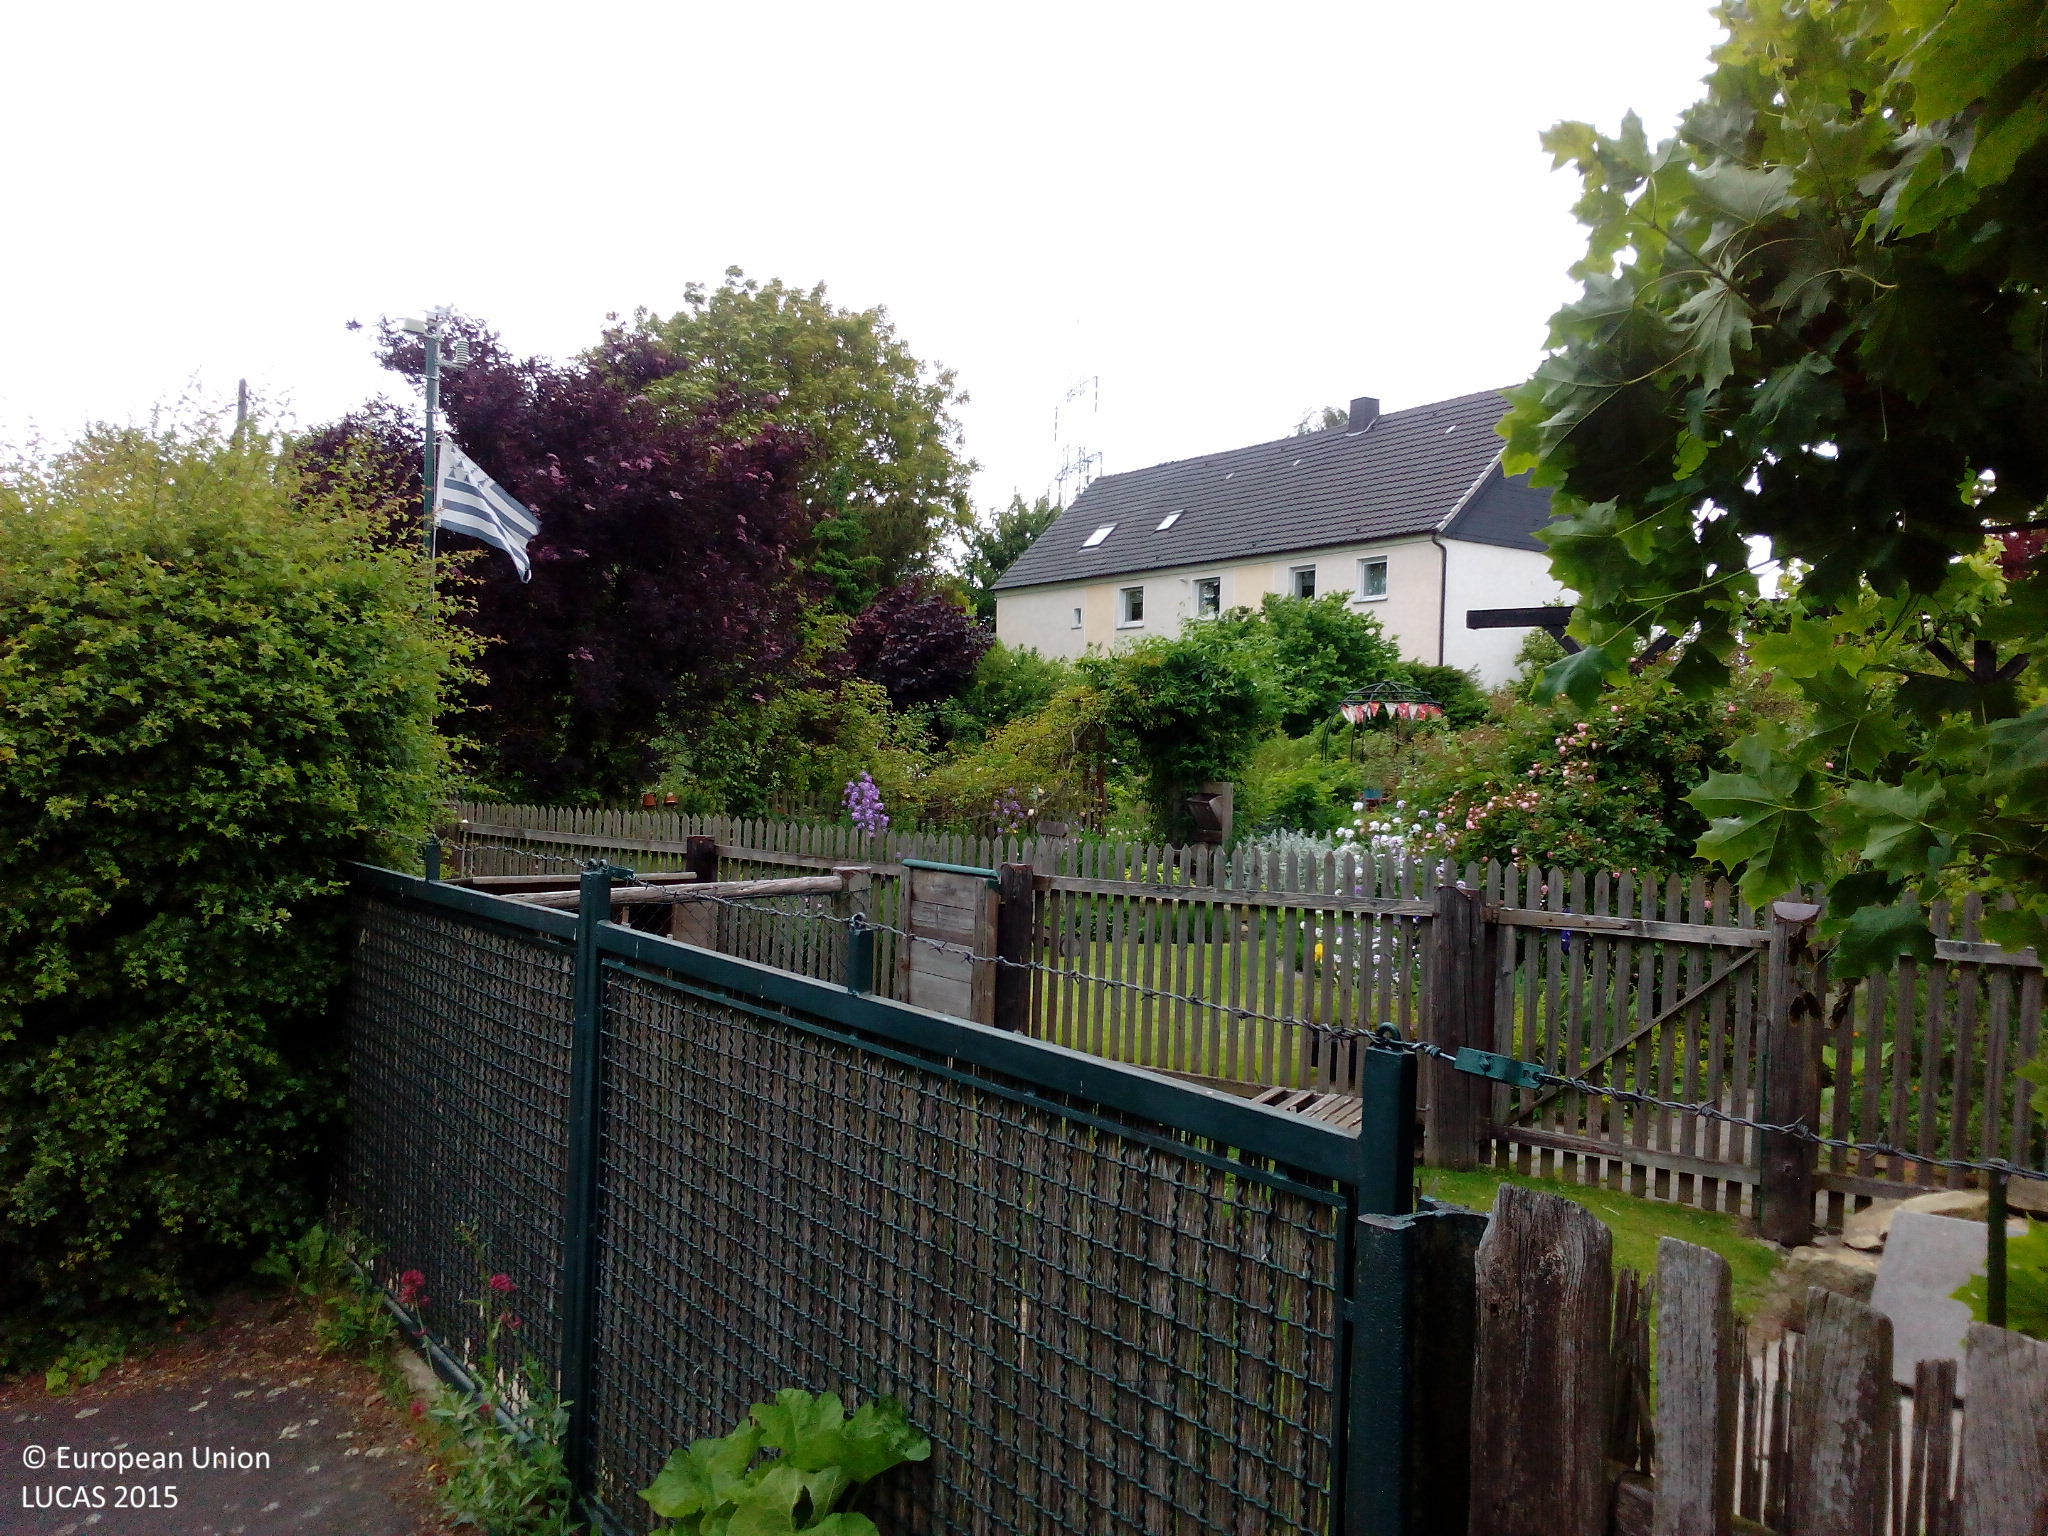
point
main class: Cropland
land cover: Floriculture and ornamental plants
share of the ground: > 75 %
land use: Residential
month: June
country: DE
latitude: 51.5514
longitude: 7.9957
